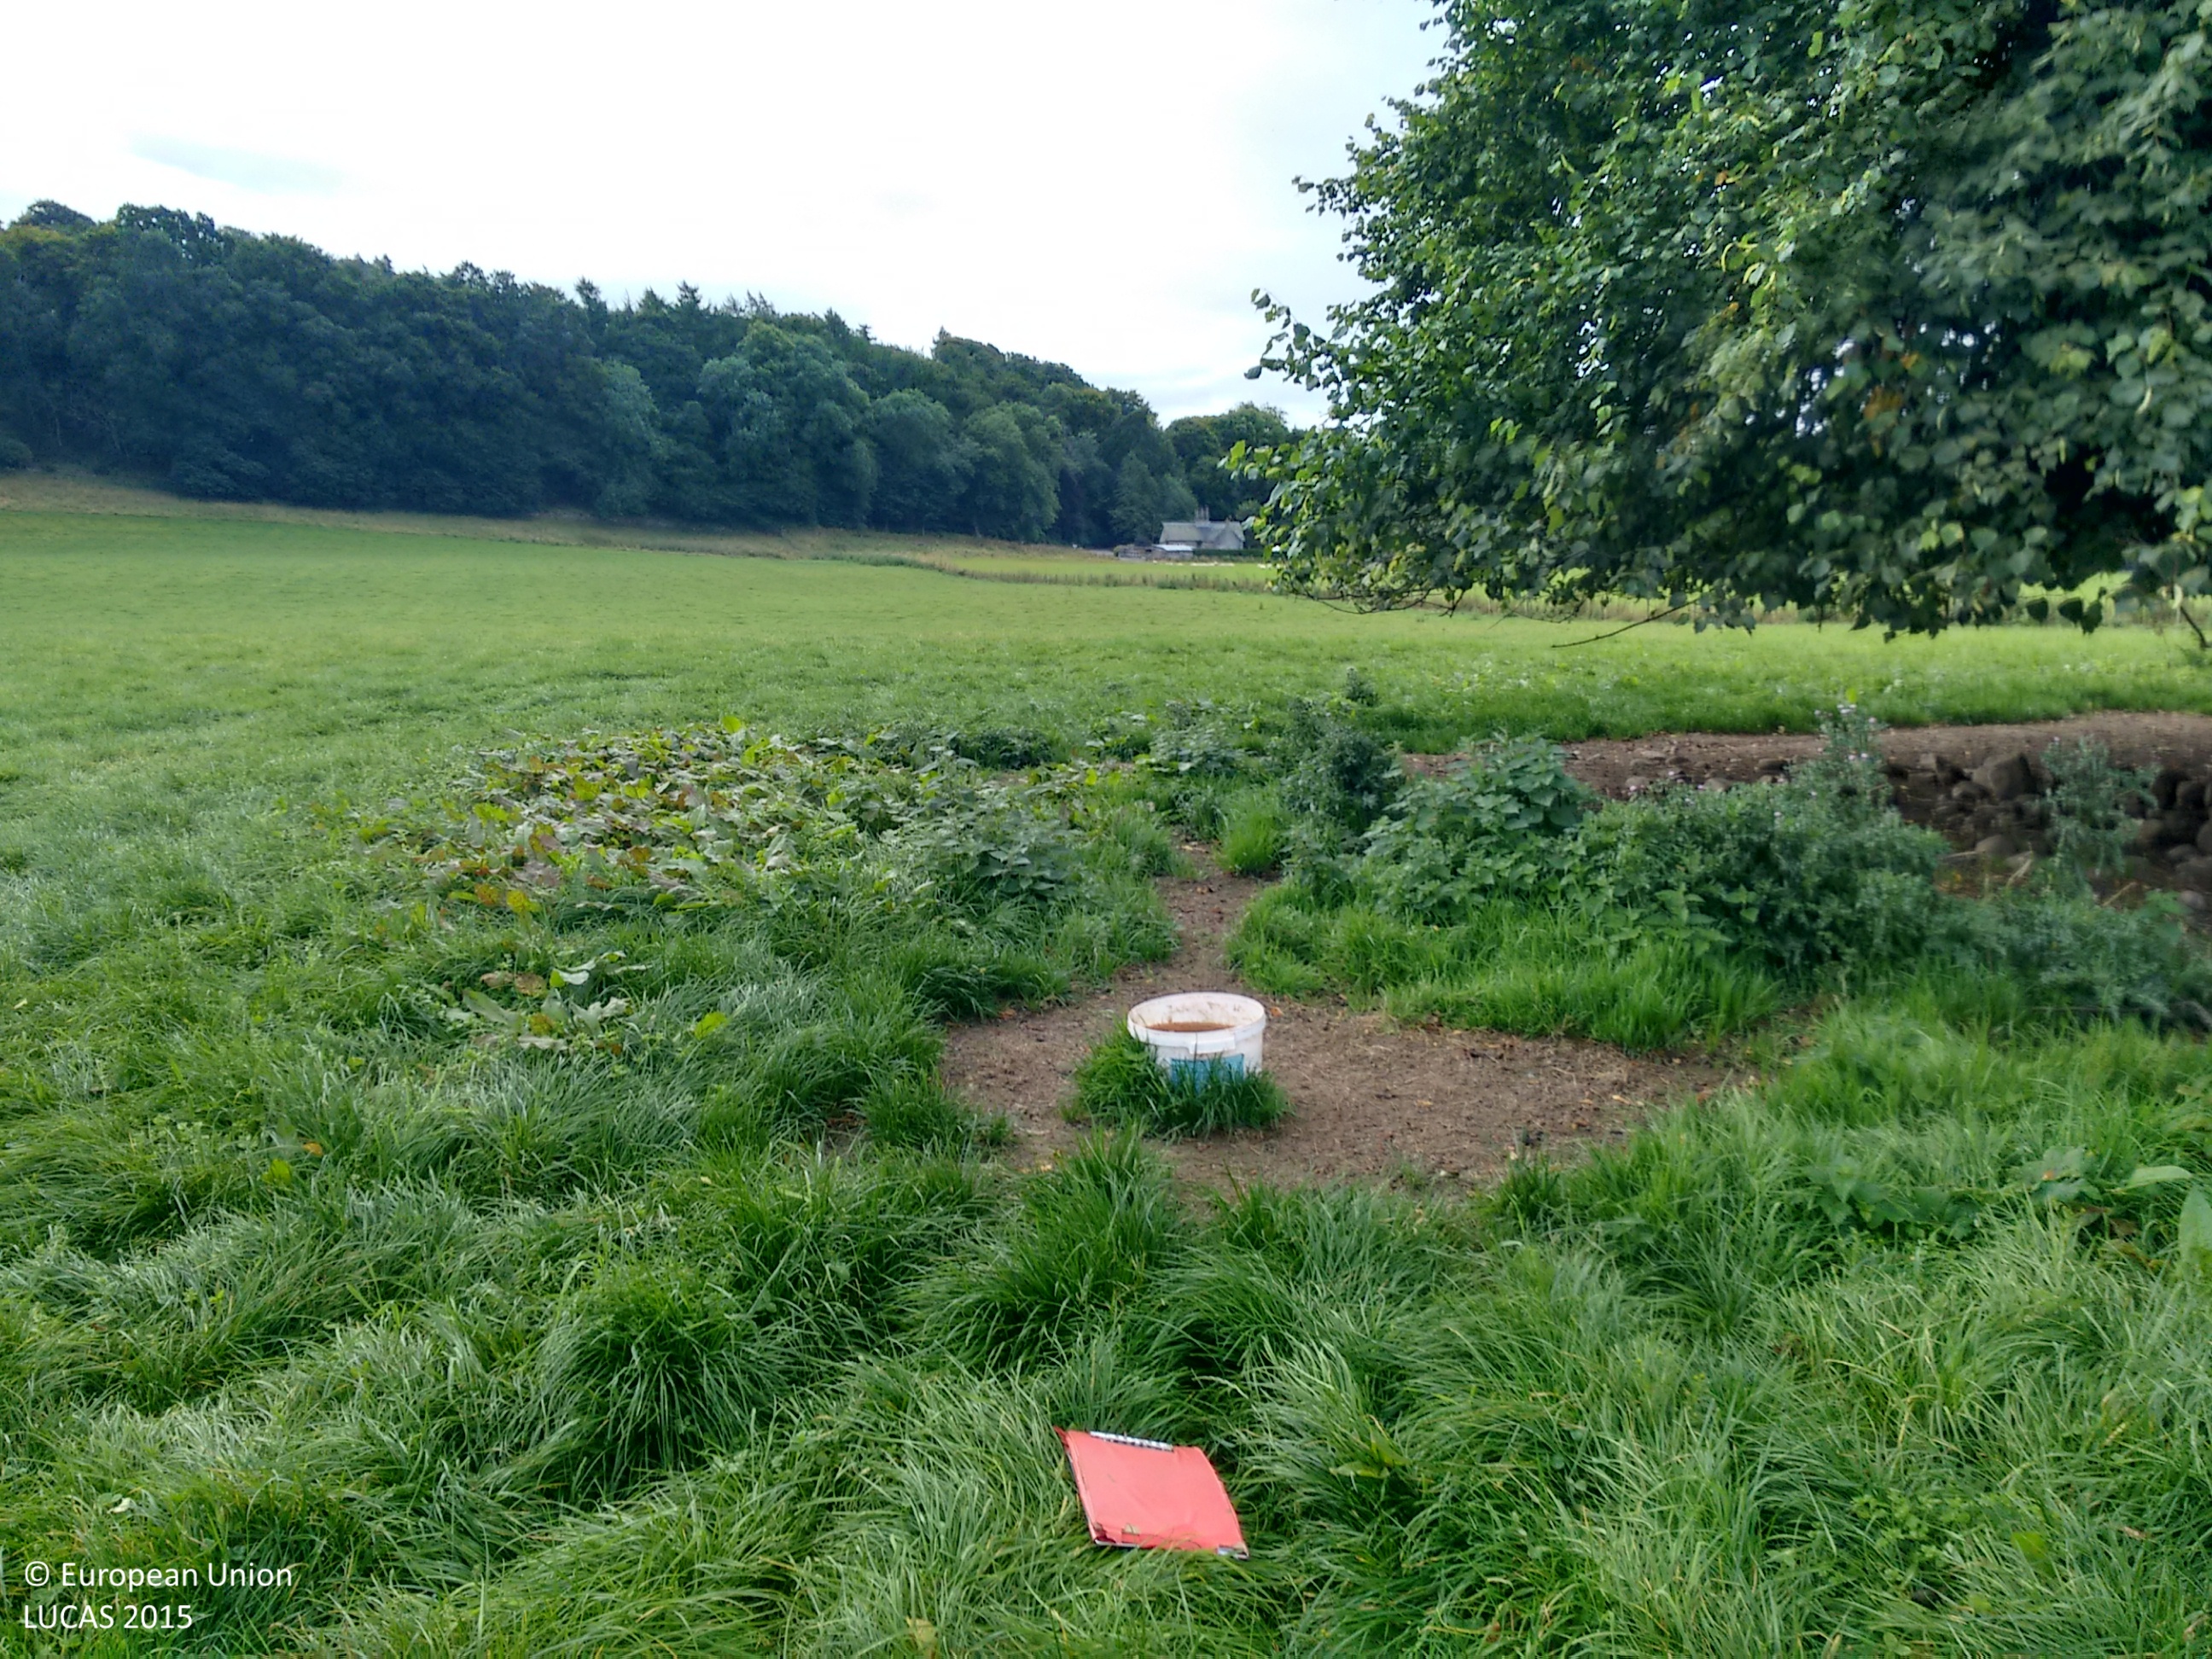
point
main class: Woodland
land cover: Broadleaved woodland
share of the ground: > 75 %
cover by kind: herbaceous plants 65 %, broadleaved forest trees 35 %
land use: Agriculture (excluding fallow land and kitchen gardens)
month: September
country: GB
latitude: 57.4193
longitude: -3.3721
